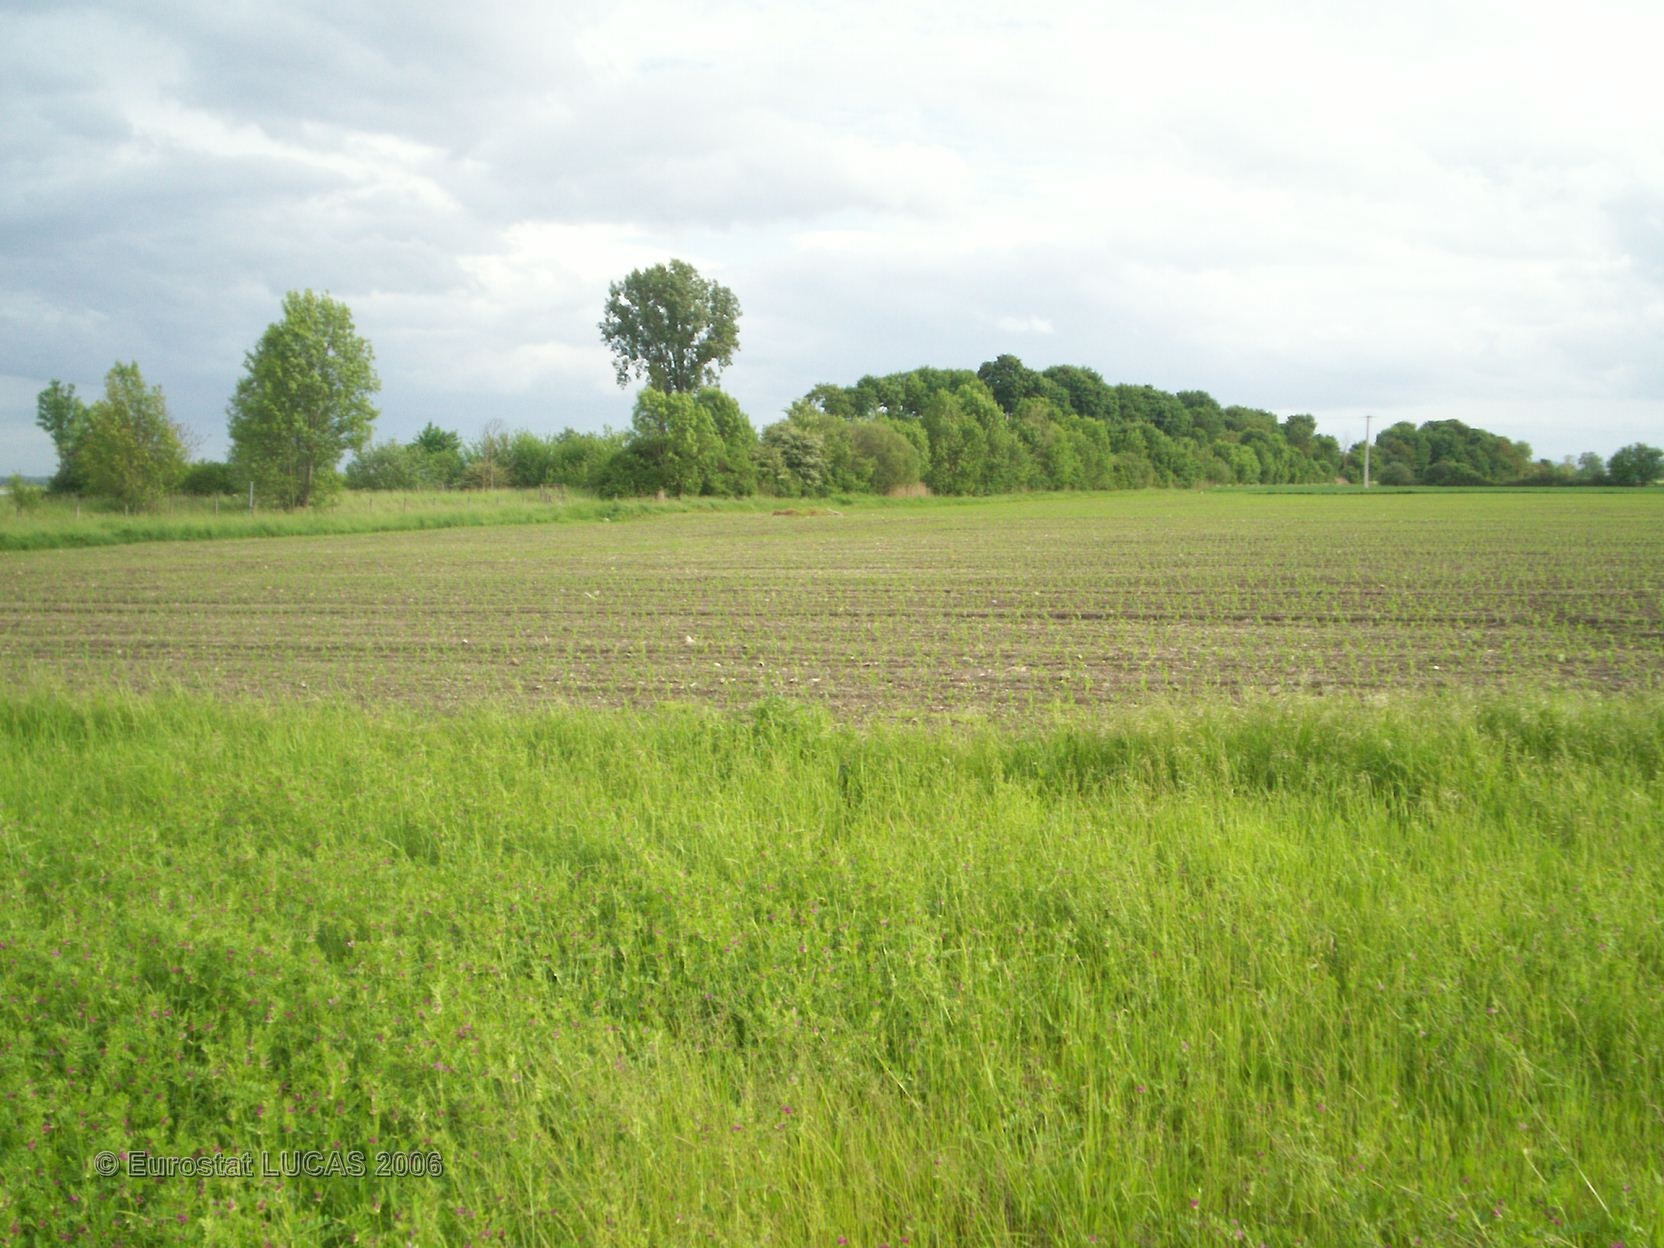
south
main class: Grassland
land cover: Grassland without tree/shrub cover
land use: Agriculture (excluding fallow land and kitchen gardens)
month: May
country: FR
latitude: 46.1545
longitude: 3.2269
